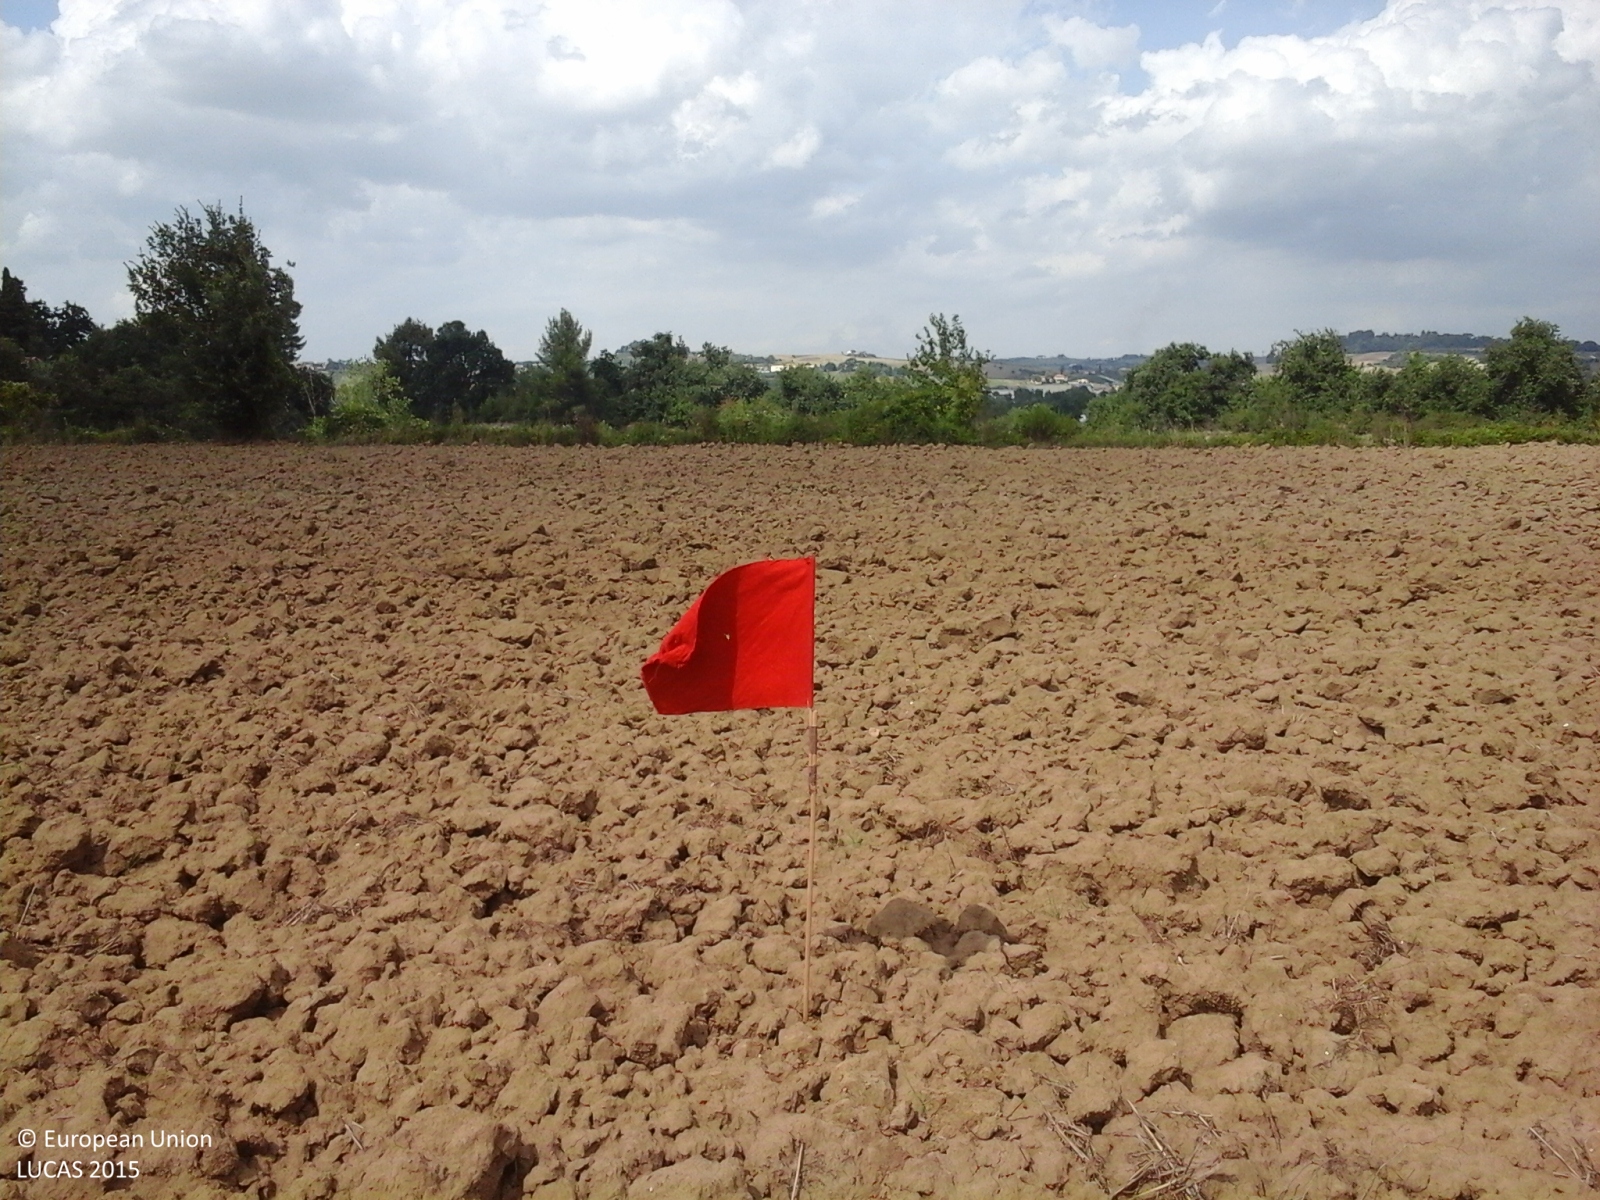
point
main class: Cropland
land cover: Durum wheat
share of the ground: < 10 %
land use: Agriculture (excluding fallow land and kitchen gardens)
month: August
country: IT
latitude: 43.4897
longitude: 13.1700
